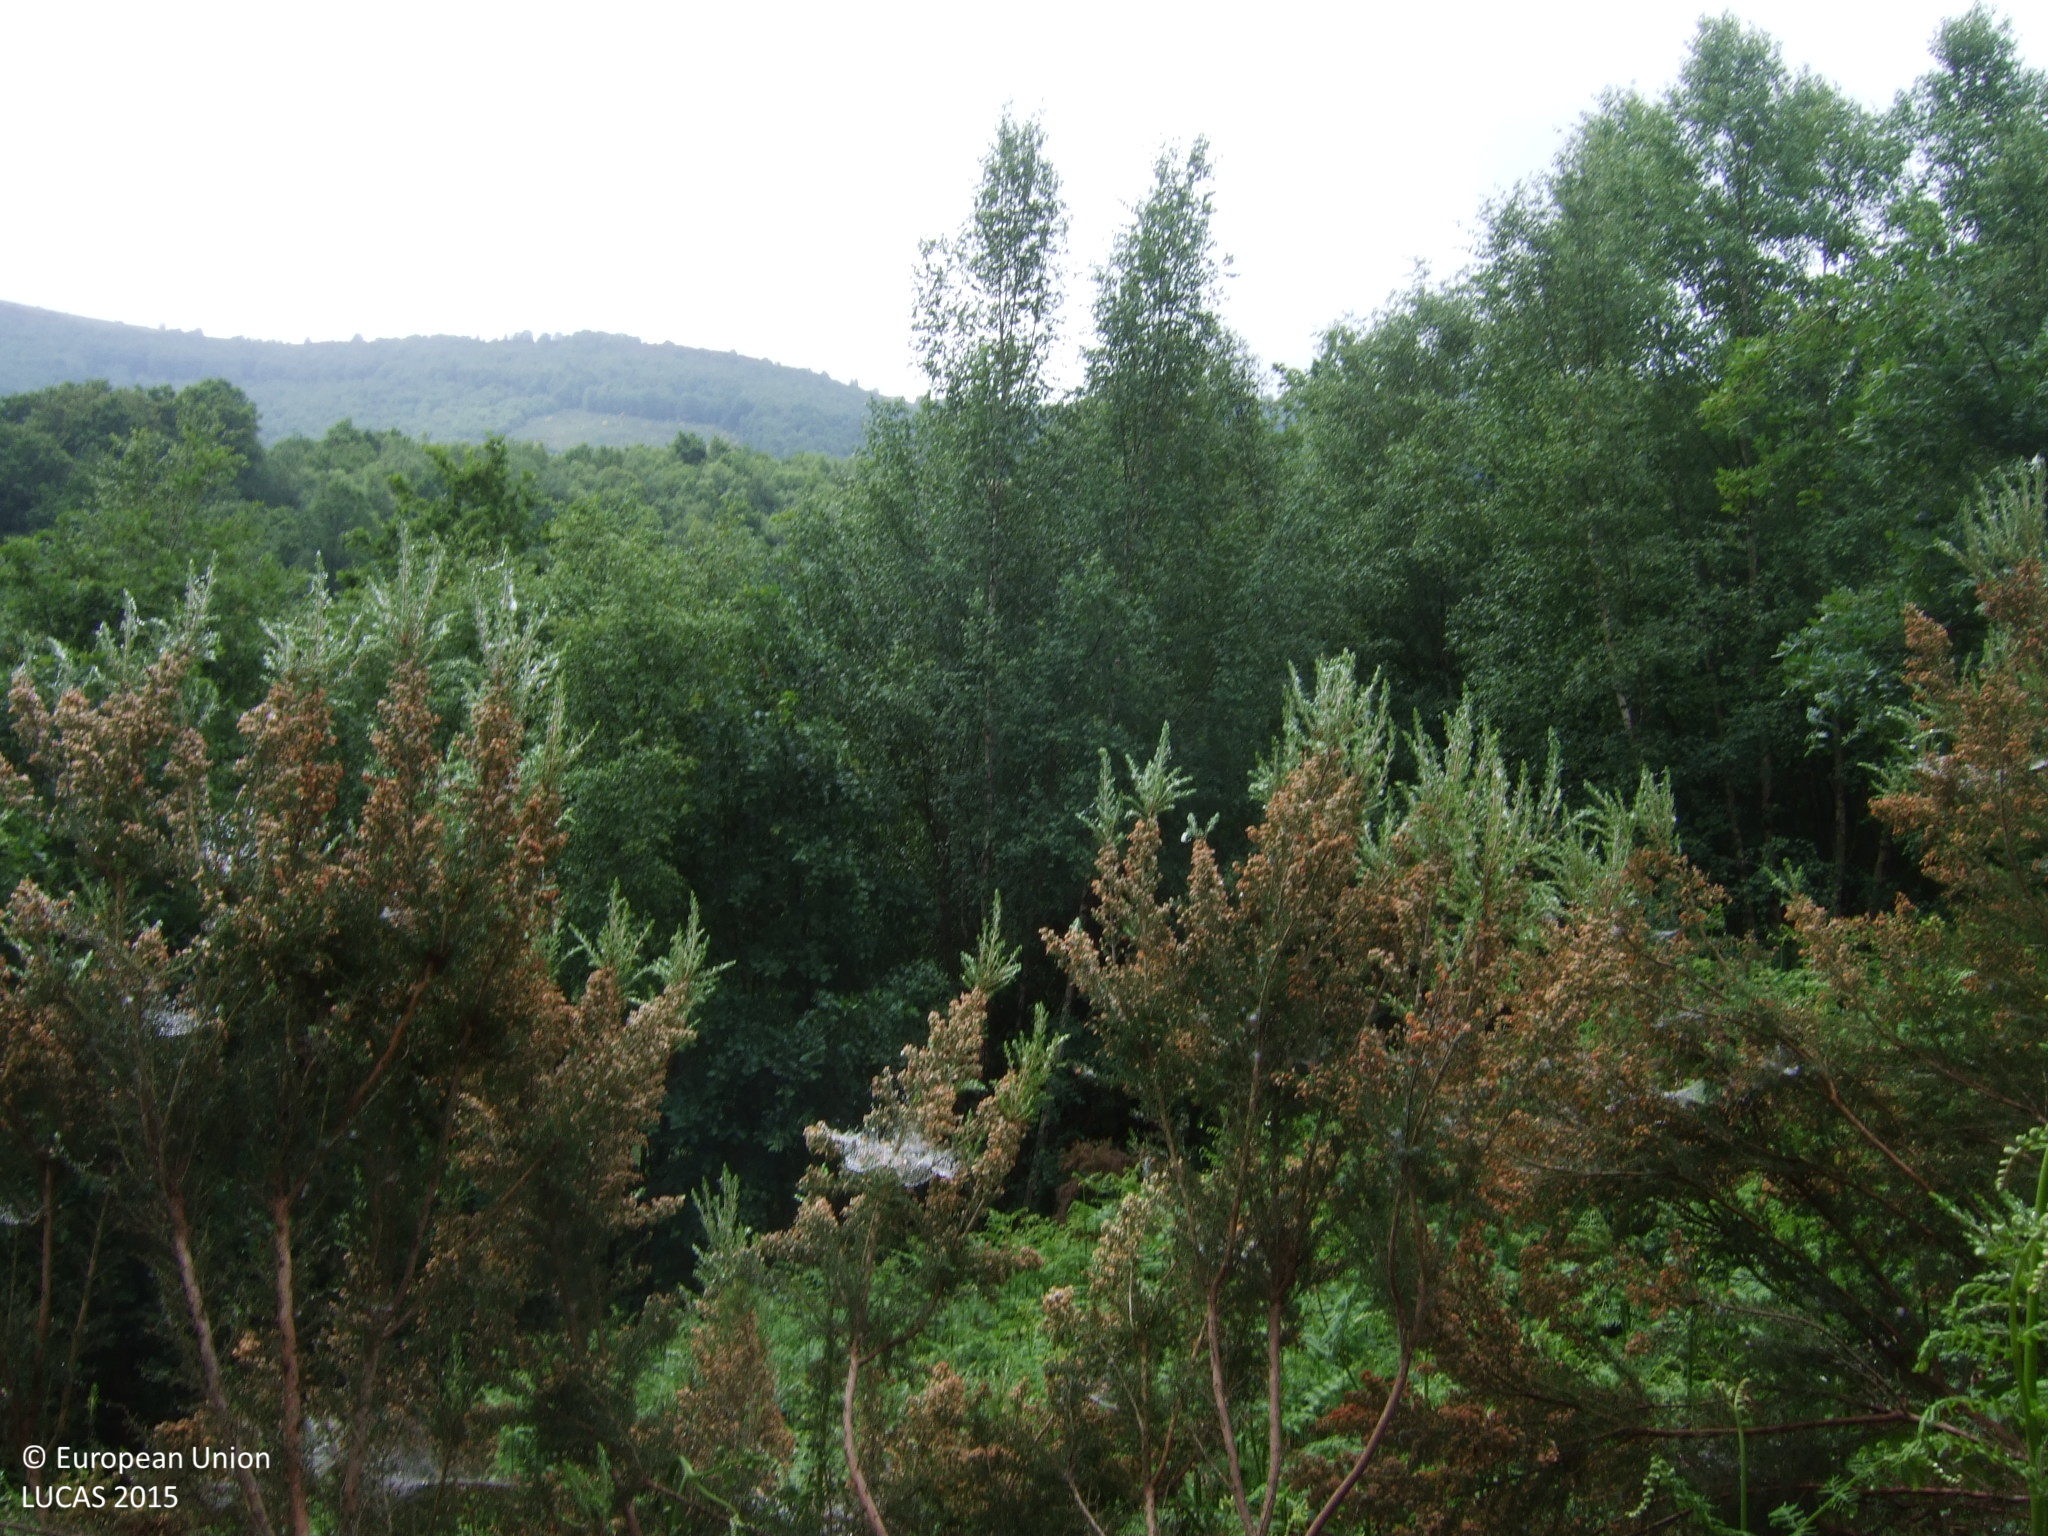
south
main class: Shrubland
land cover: Shrubland with sparse tree cover
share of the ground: > 75 %
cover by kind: shrubs 95 %, broadleaved forest trees 5 %
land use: Semi-natural and natural areas not in use
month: June
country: ES
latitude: 42.7280
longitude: -7.3494
